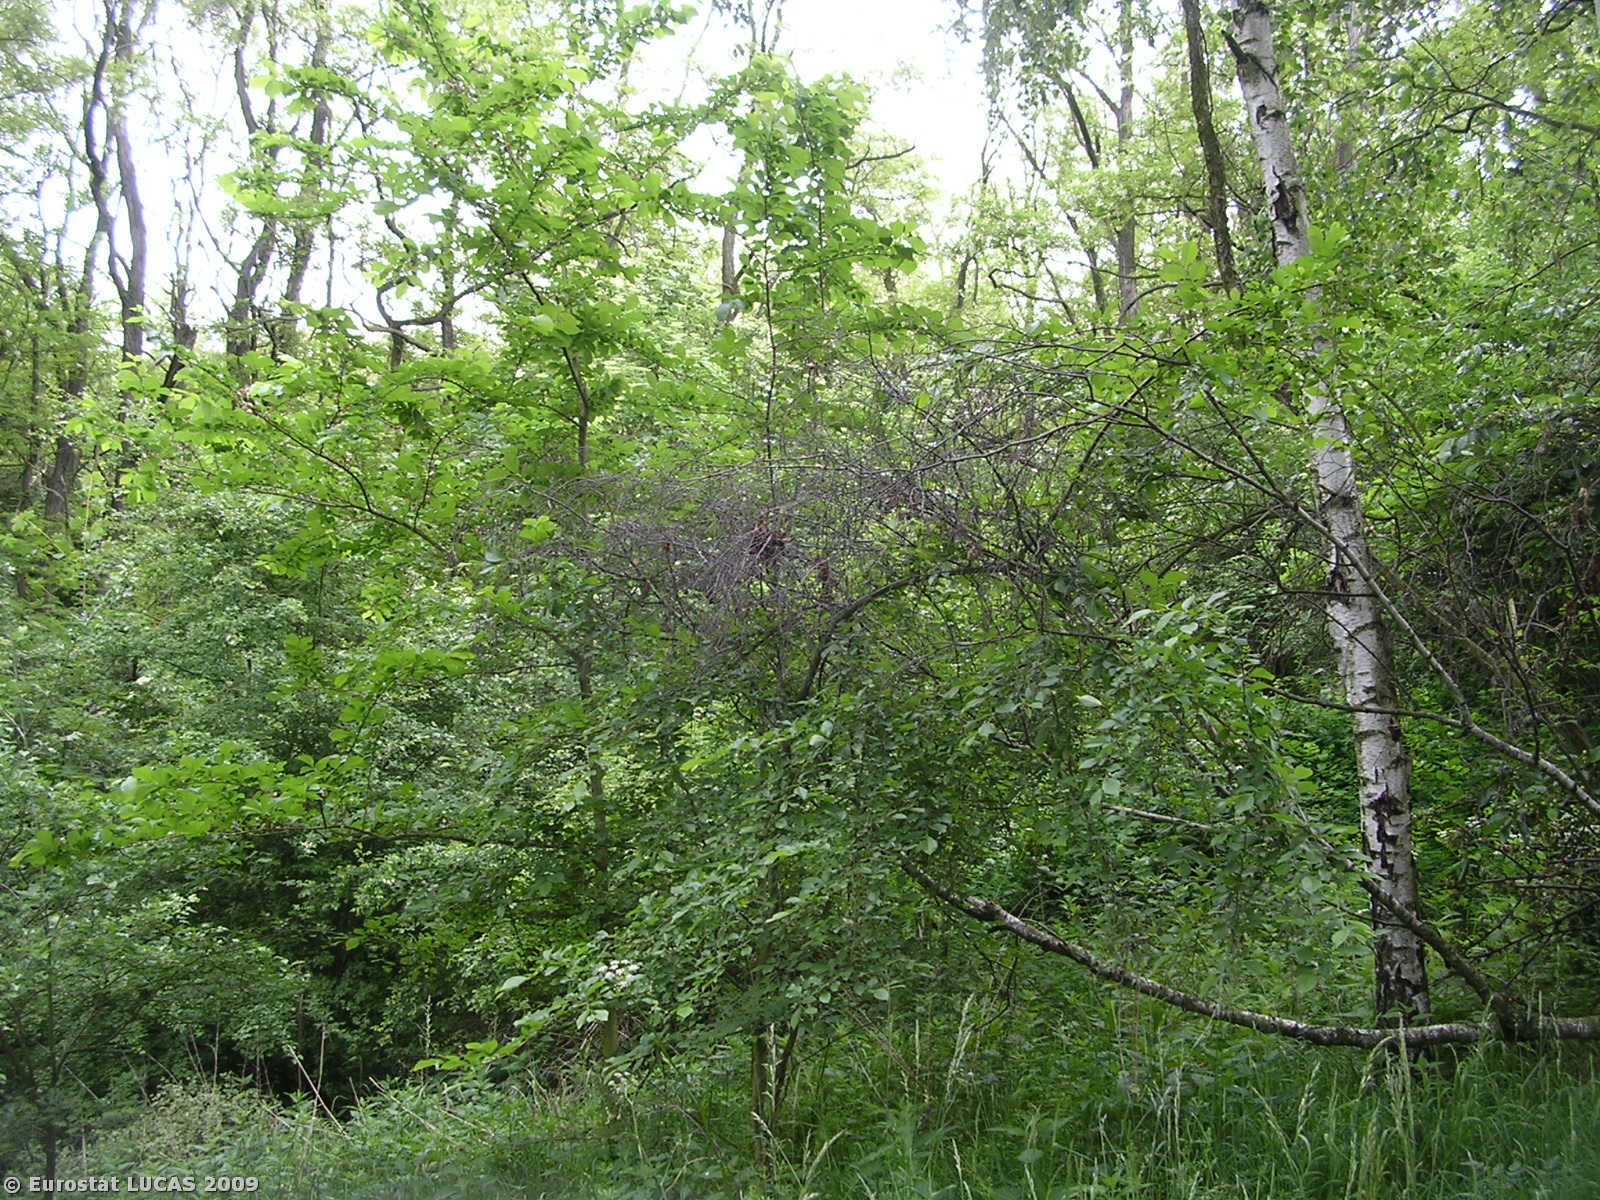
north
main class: Woodland
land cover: Broadleaved woodland
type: non-riverine alder, birch or aspen forest
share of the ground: 50 - 75 %
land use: Forestry
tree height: > 5 m
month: May
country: CZ
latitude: 50.1763
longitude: 14.2721
